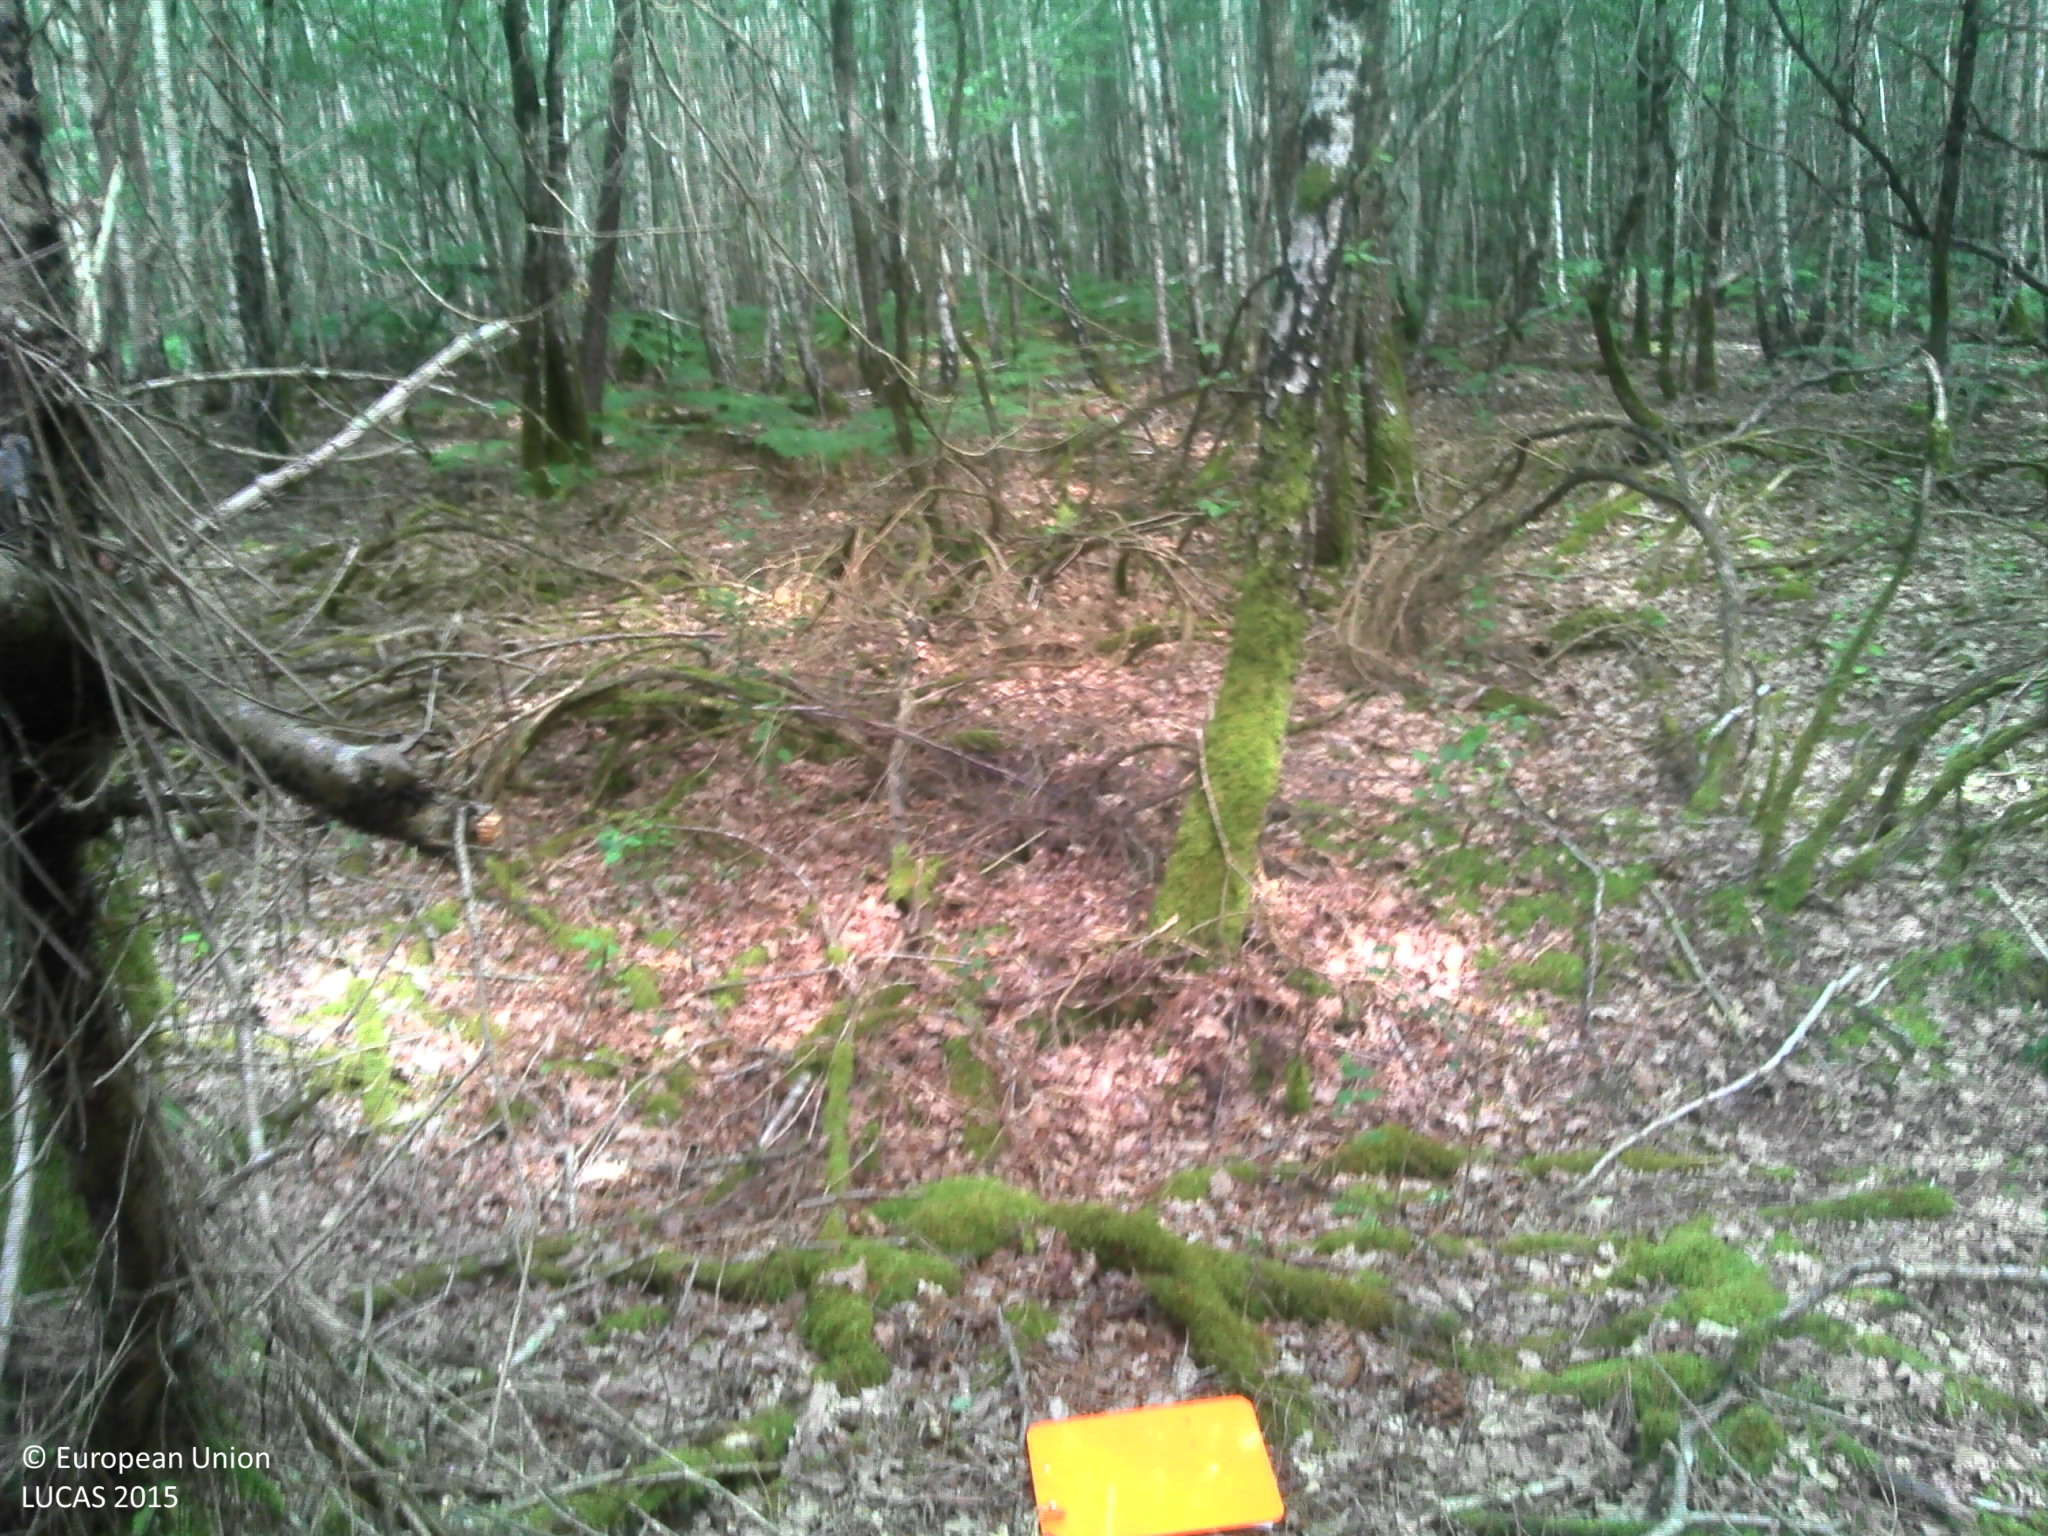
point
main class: Woodland
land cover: Pine dominated mixed woodland
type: thermophilous deciduous forest
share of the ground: > 75 %
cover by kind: unconsolidated bare surface 30 %, herbaceous plants 20 %, lichens and mosses 20 %, coniferous forest trees 15 %, broadleaved forest trees 15 %
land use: Forestry
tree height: > 5 m
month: June
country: FR
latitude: 47.3417
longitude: 1.3694
